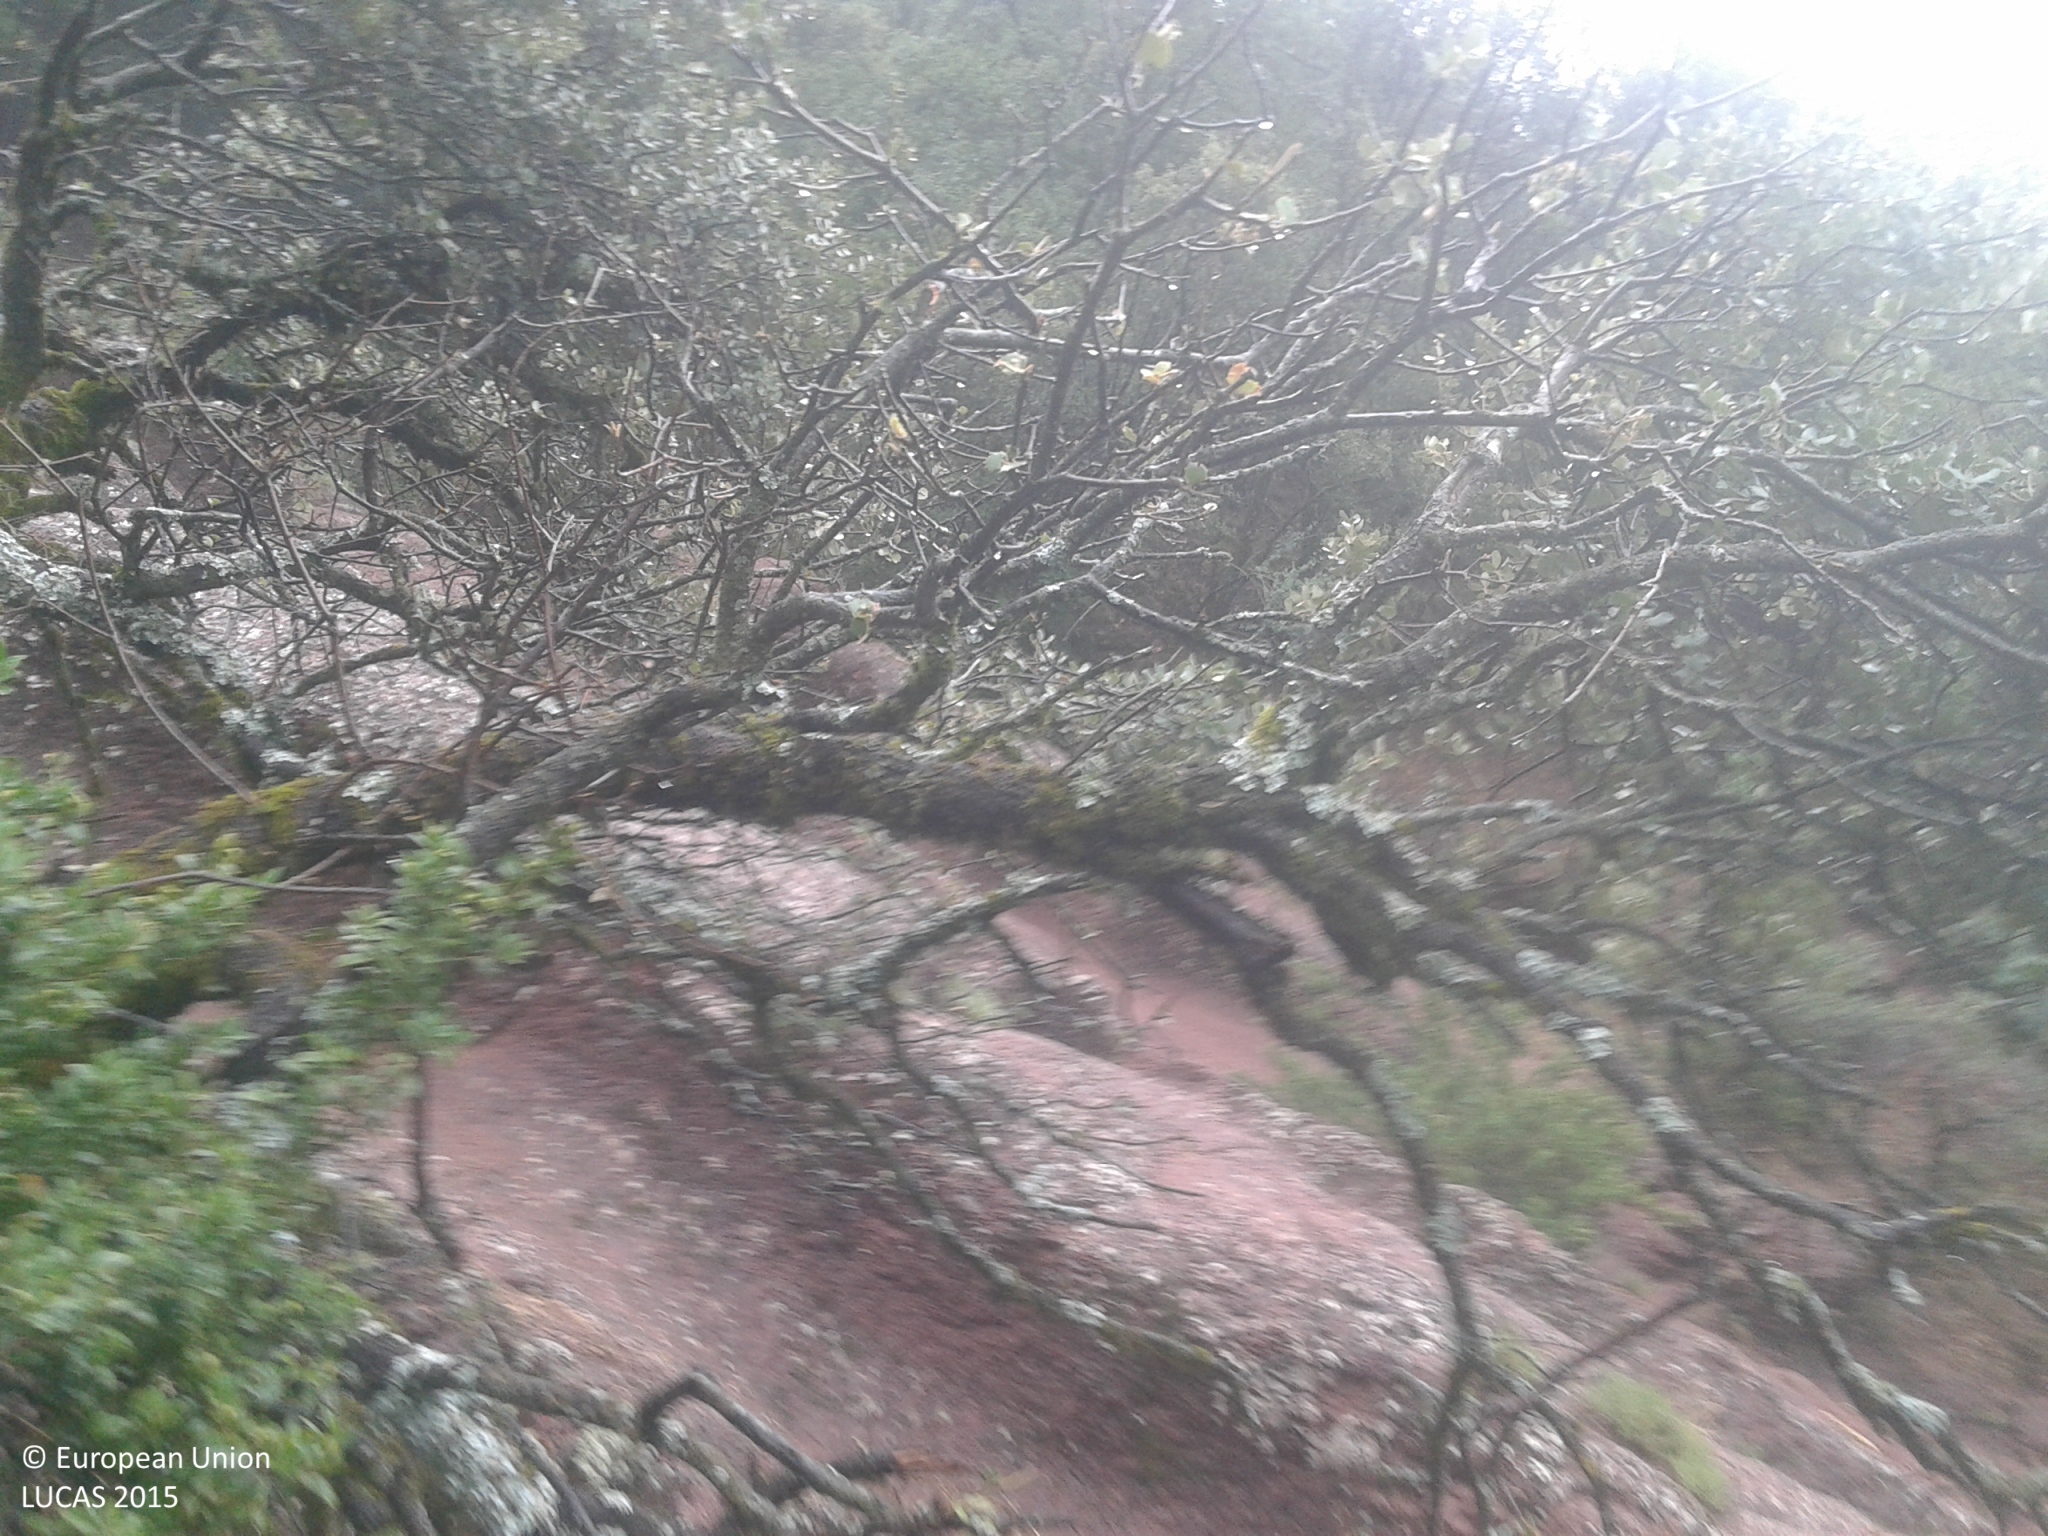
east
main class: Woodland
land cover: Broadleaved woodland
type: broadleaved evergreen forest
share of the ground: > 75 %
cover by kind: broadleaved forest trees 90 %, shrubs 10 %
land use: Semi-natural and natural areas not in use
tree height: > 5 m
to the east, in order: Broadleaved woodland
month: August
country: ES
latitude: 42.3848
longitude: 1.0564
